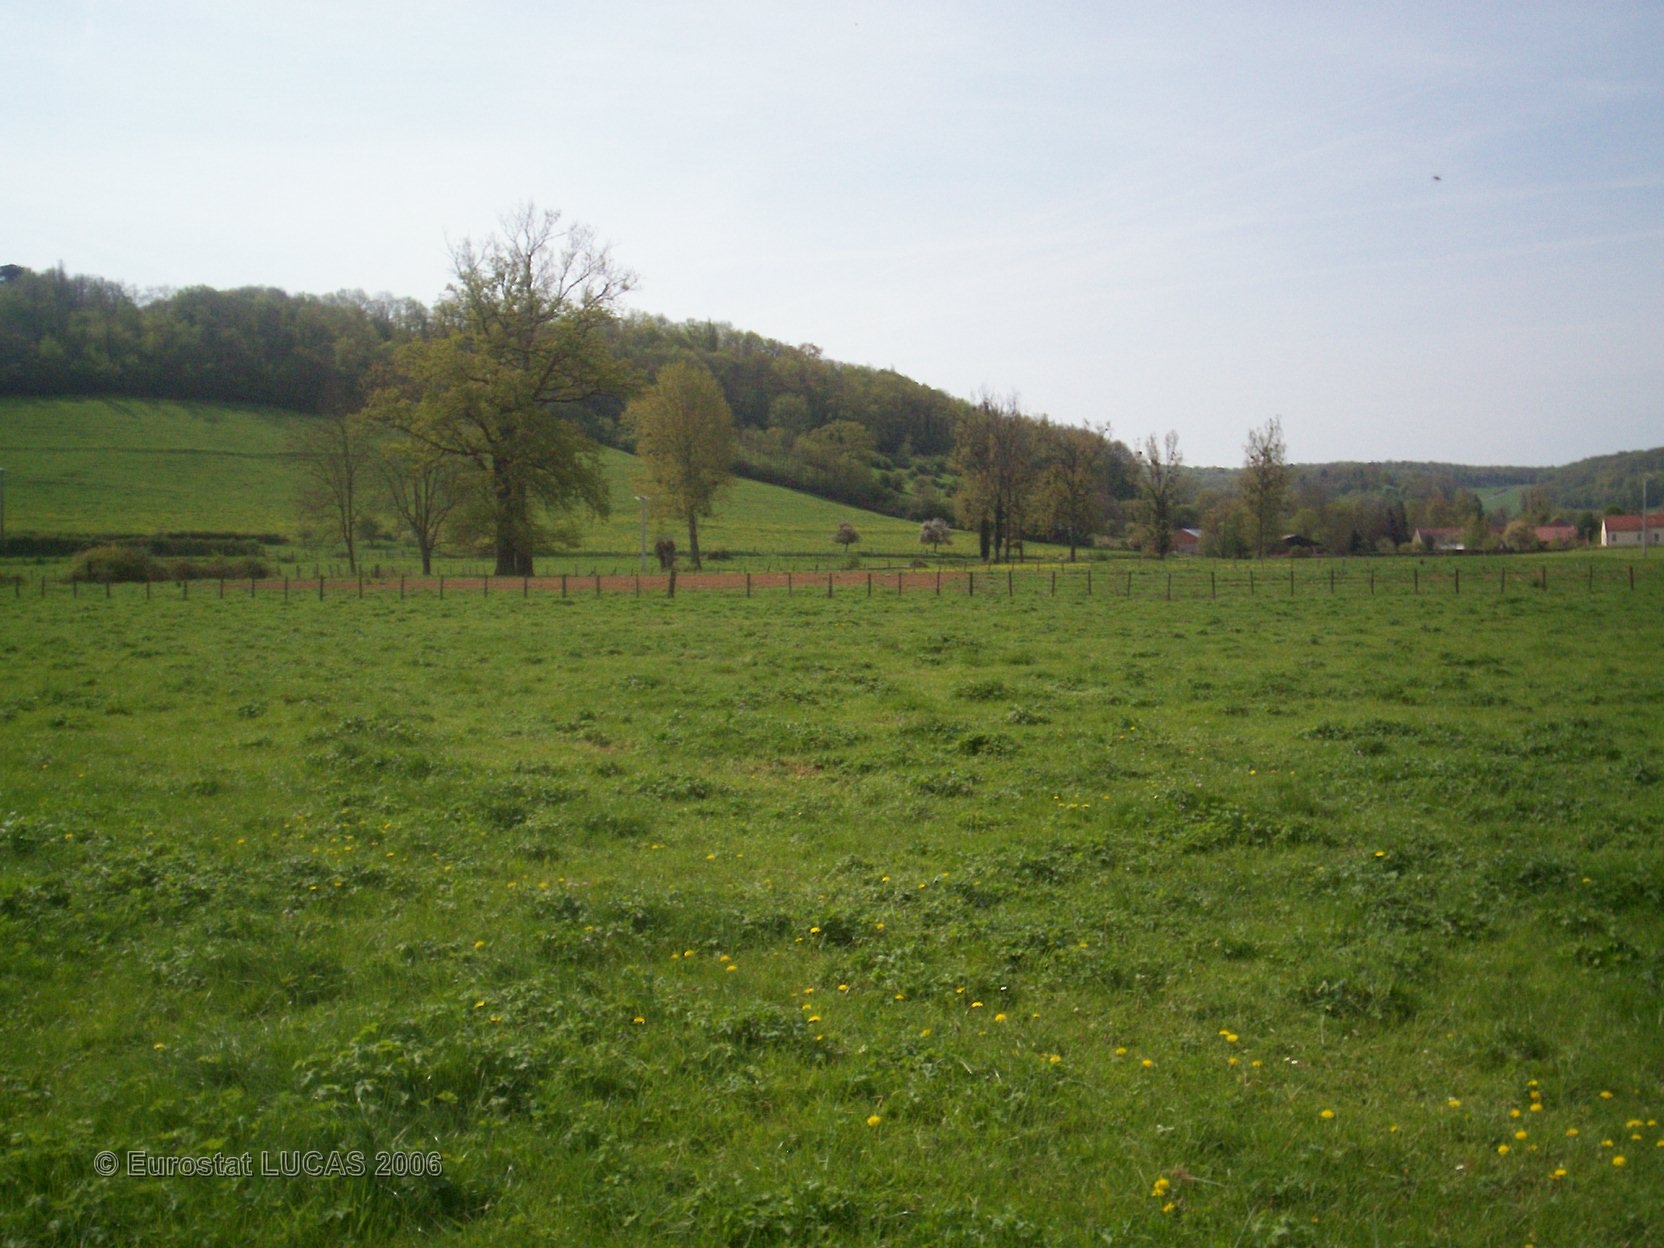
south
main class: Grassland
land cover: Grassland without tree/shrub cover
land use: Agriculture (excluding fallow land and kitchen gardens)
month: May
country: FR
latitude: 47.4420
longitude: 4.6023
